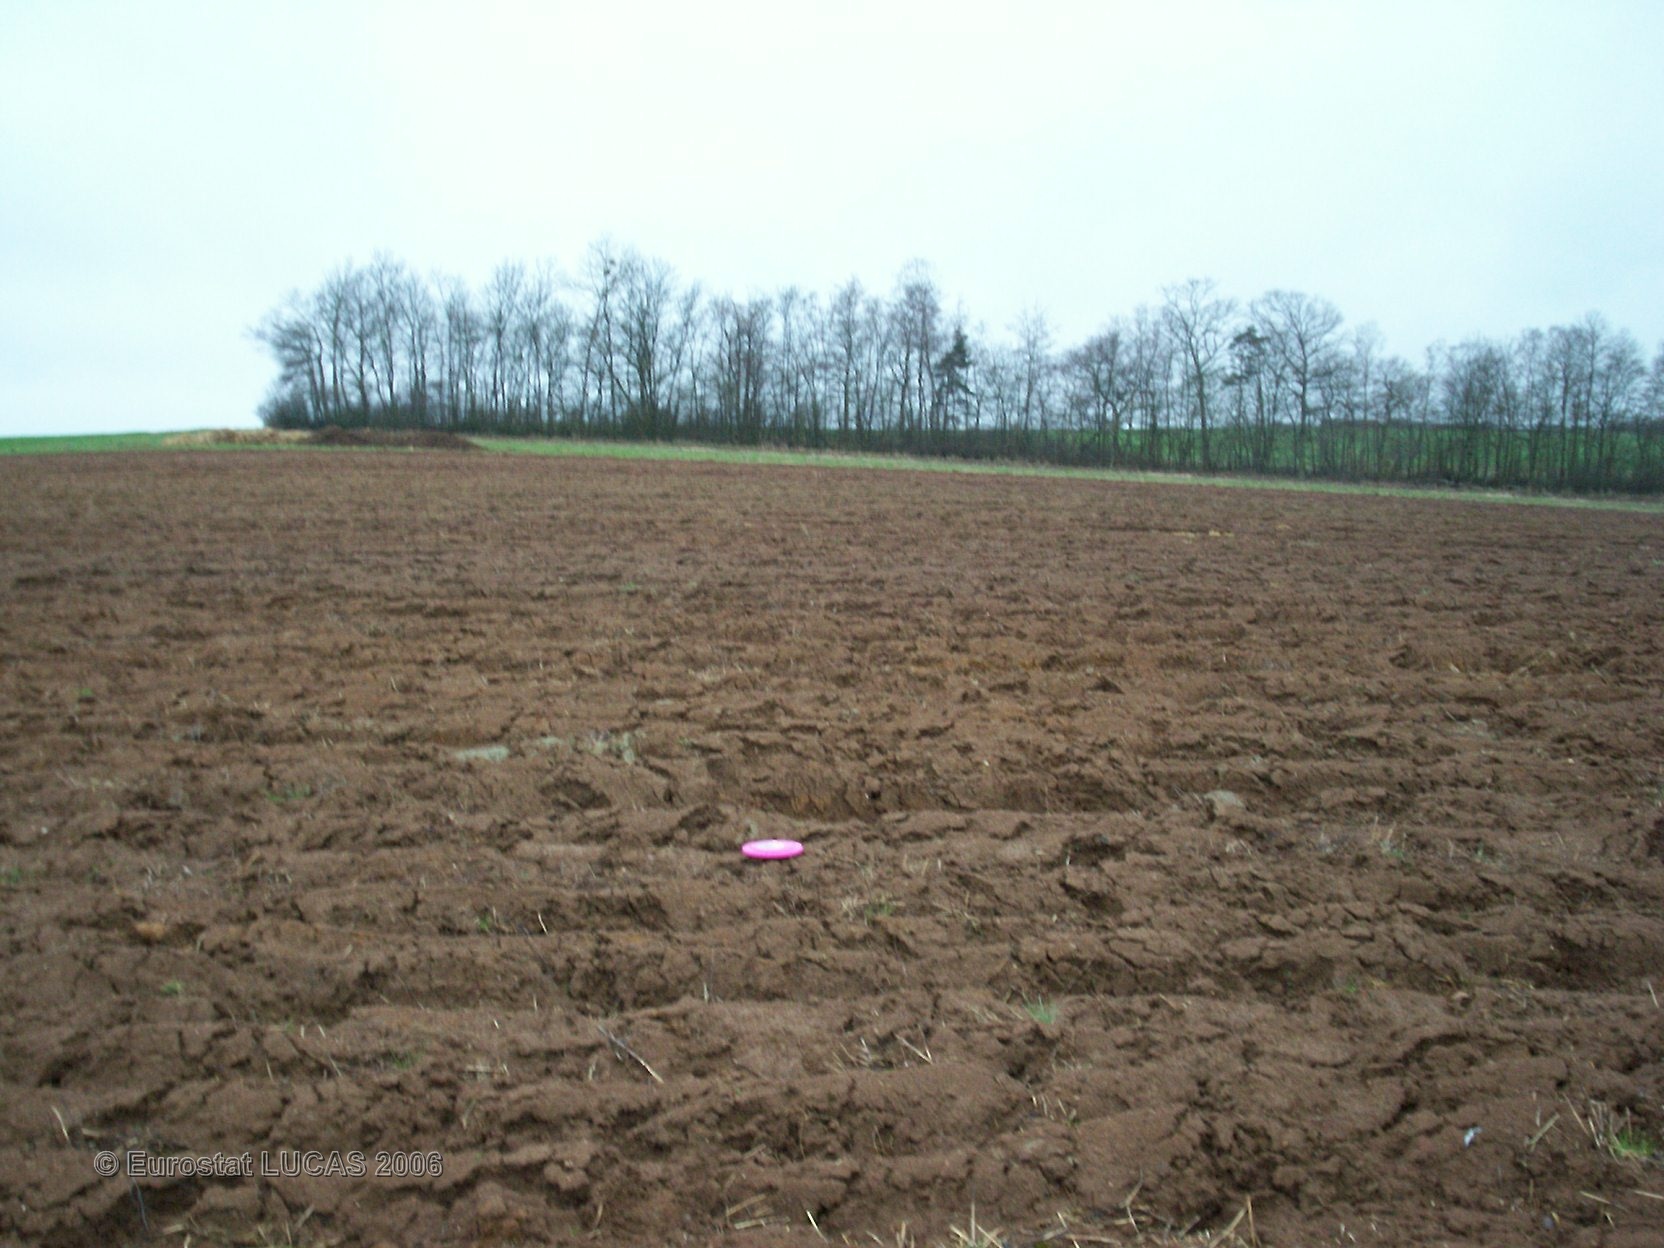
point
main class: Cropland
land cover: Maize
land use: Agriculture (excluding fallow land and kitchen gardens)
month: May
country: FR
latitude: 48.5902
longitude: 6.7602
